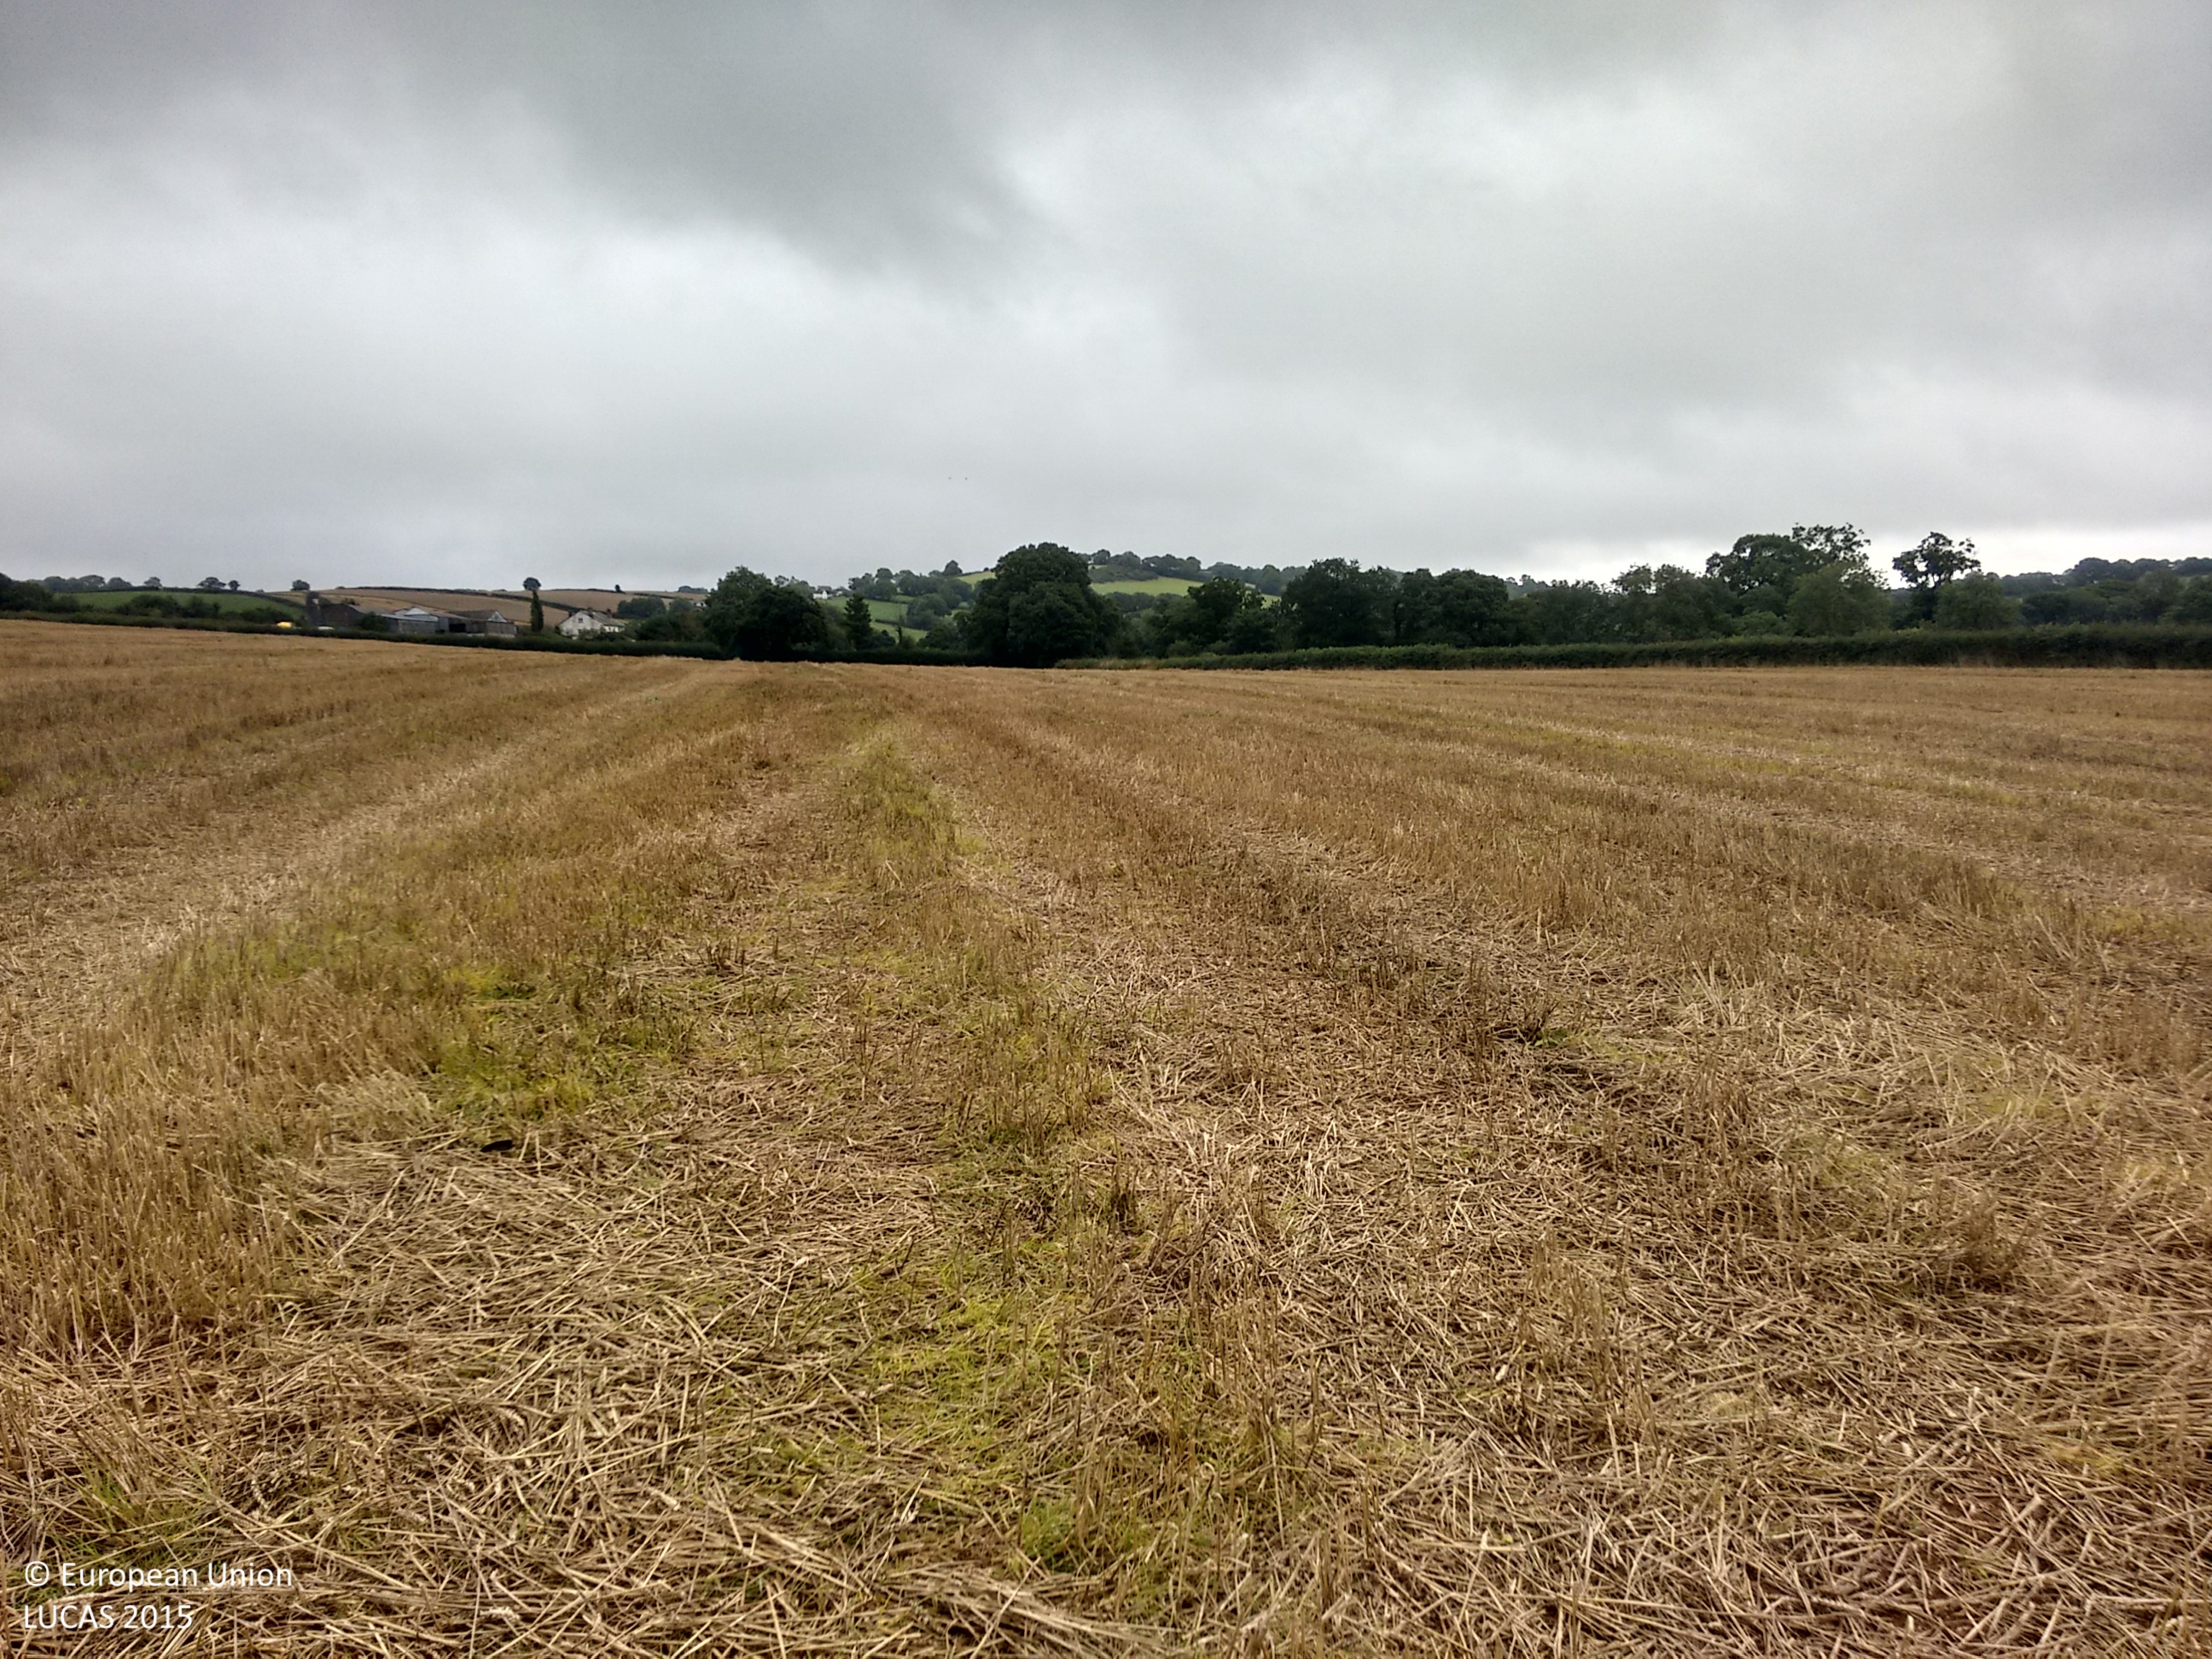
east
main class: Cropland
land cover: Barley
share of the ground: > 75 %
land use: Agriculture (excluding fallow land and kitchen gardens)
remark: Harvested field
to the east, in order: Barley; Managed hedges; Fences; Grassland without tree/shrub cover; Ditches and canals; Broadleaved woodland; Fences; Ditches and canals; Grassland without tree/shrub cover
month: August
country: GB
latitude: 50.8606
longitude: -3.5969
